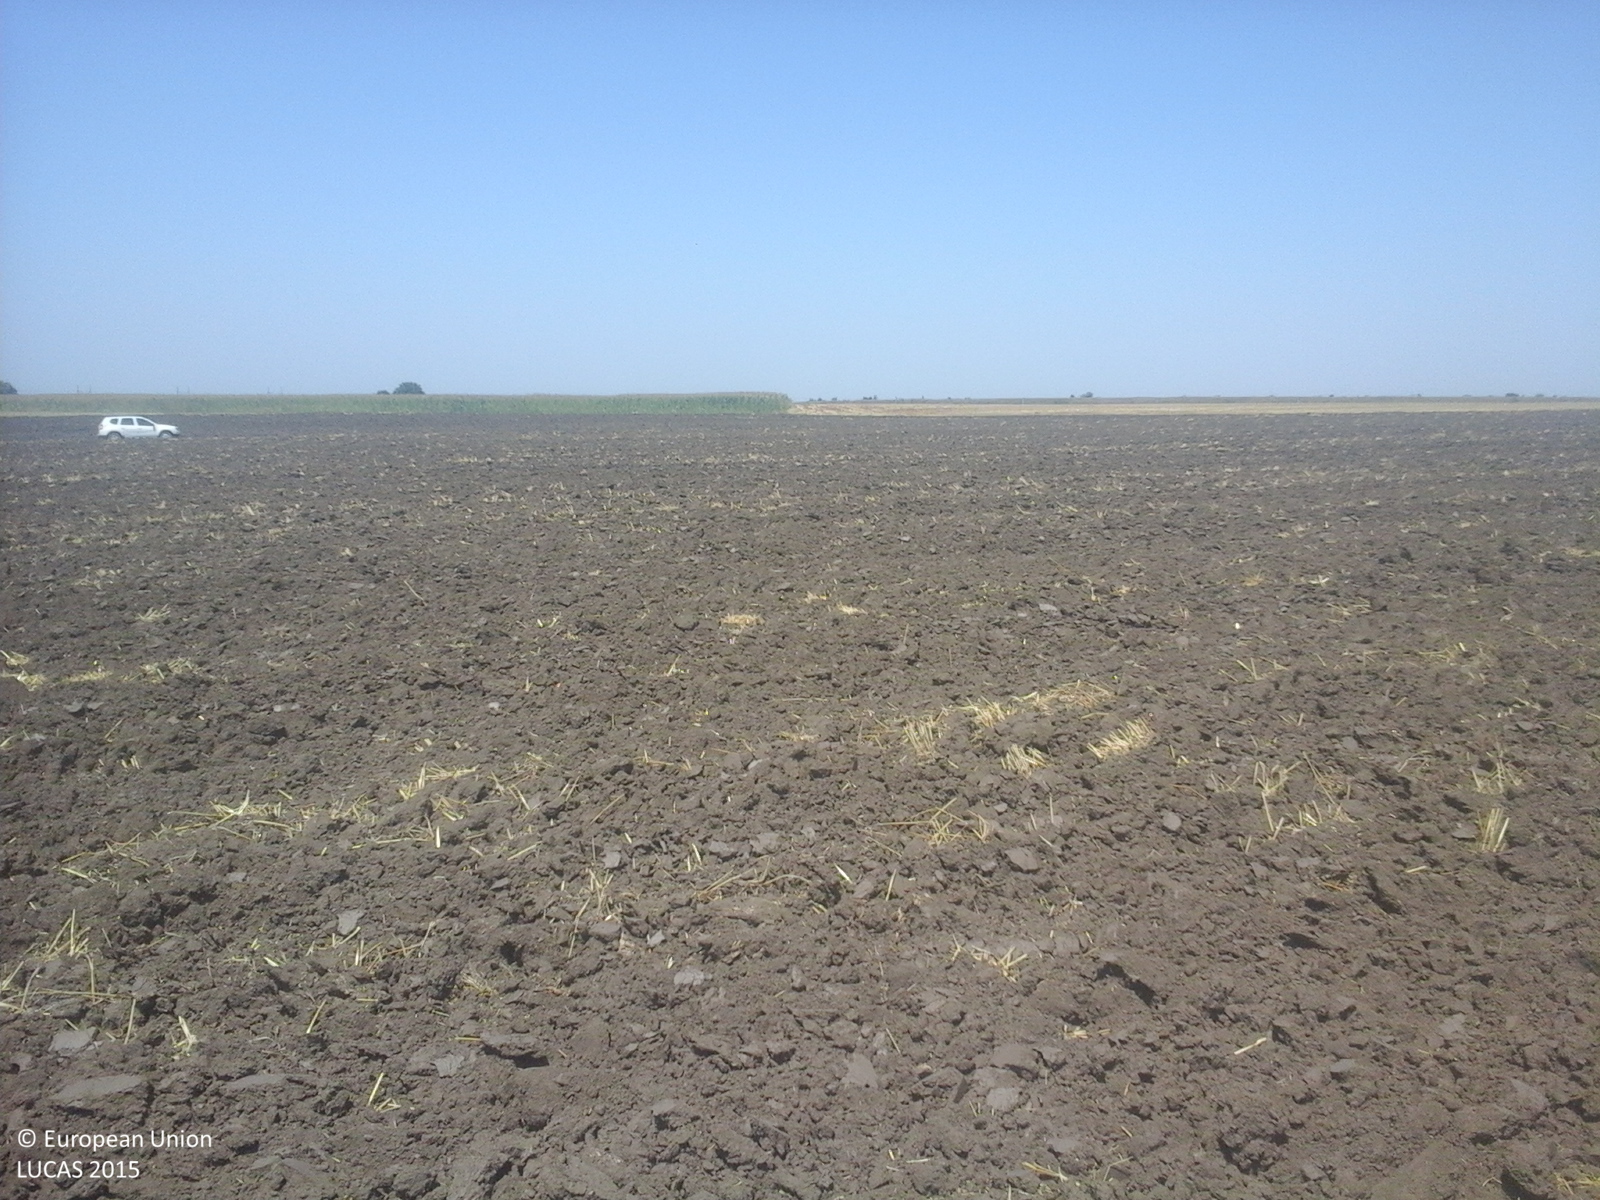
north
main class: Cropland
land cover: Durum wheat
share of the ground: < 10 %
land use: Agriculture (excluding fallow land and kitchen gardens)
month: July
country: RO
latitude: 44.4395
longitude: 26.6919
